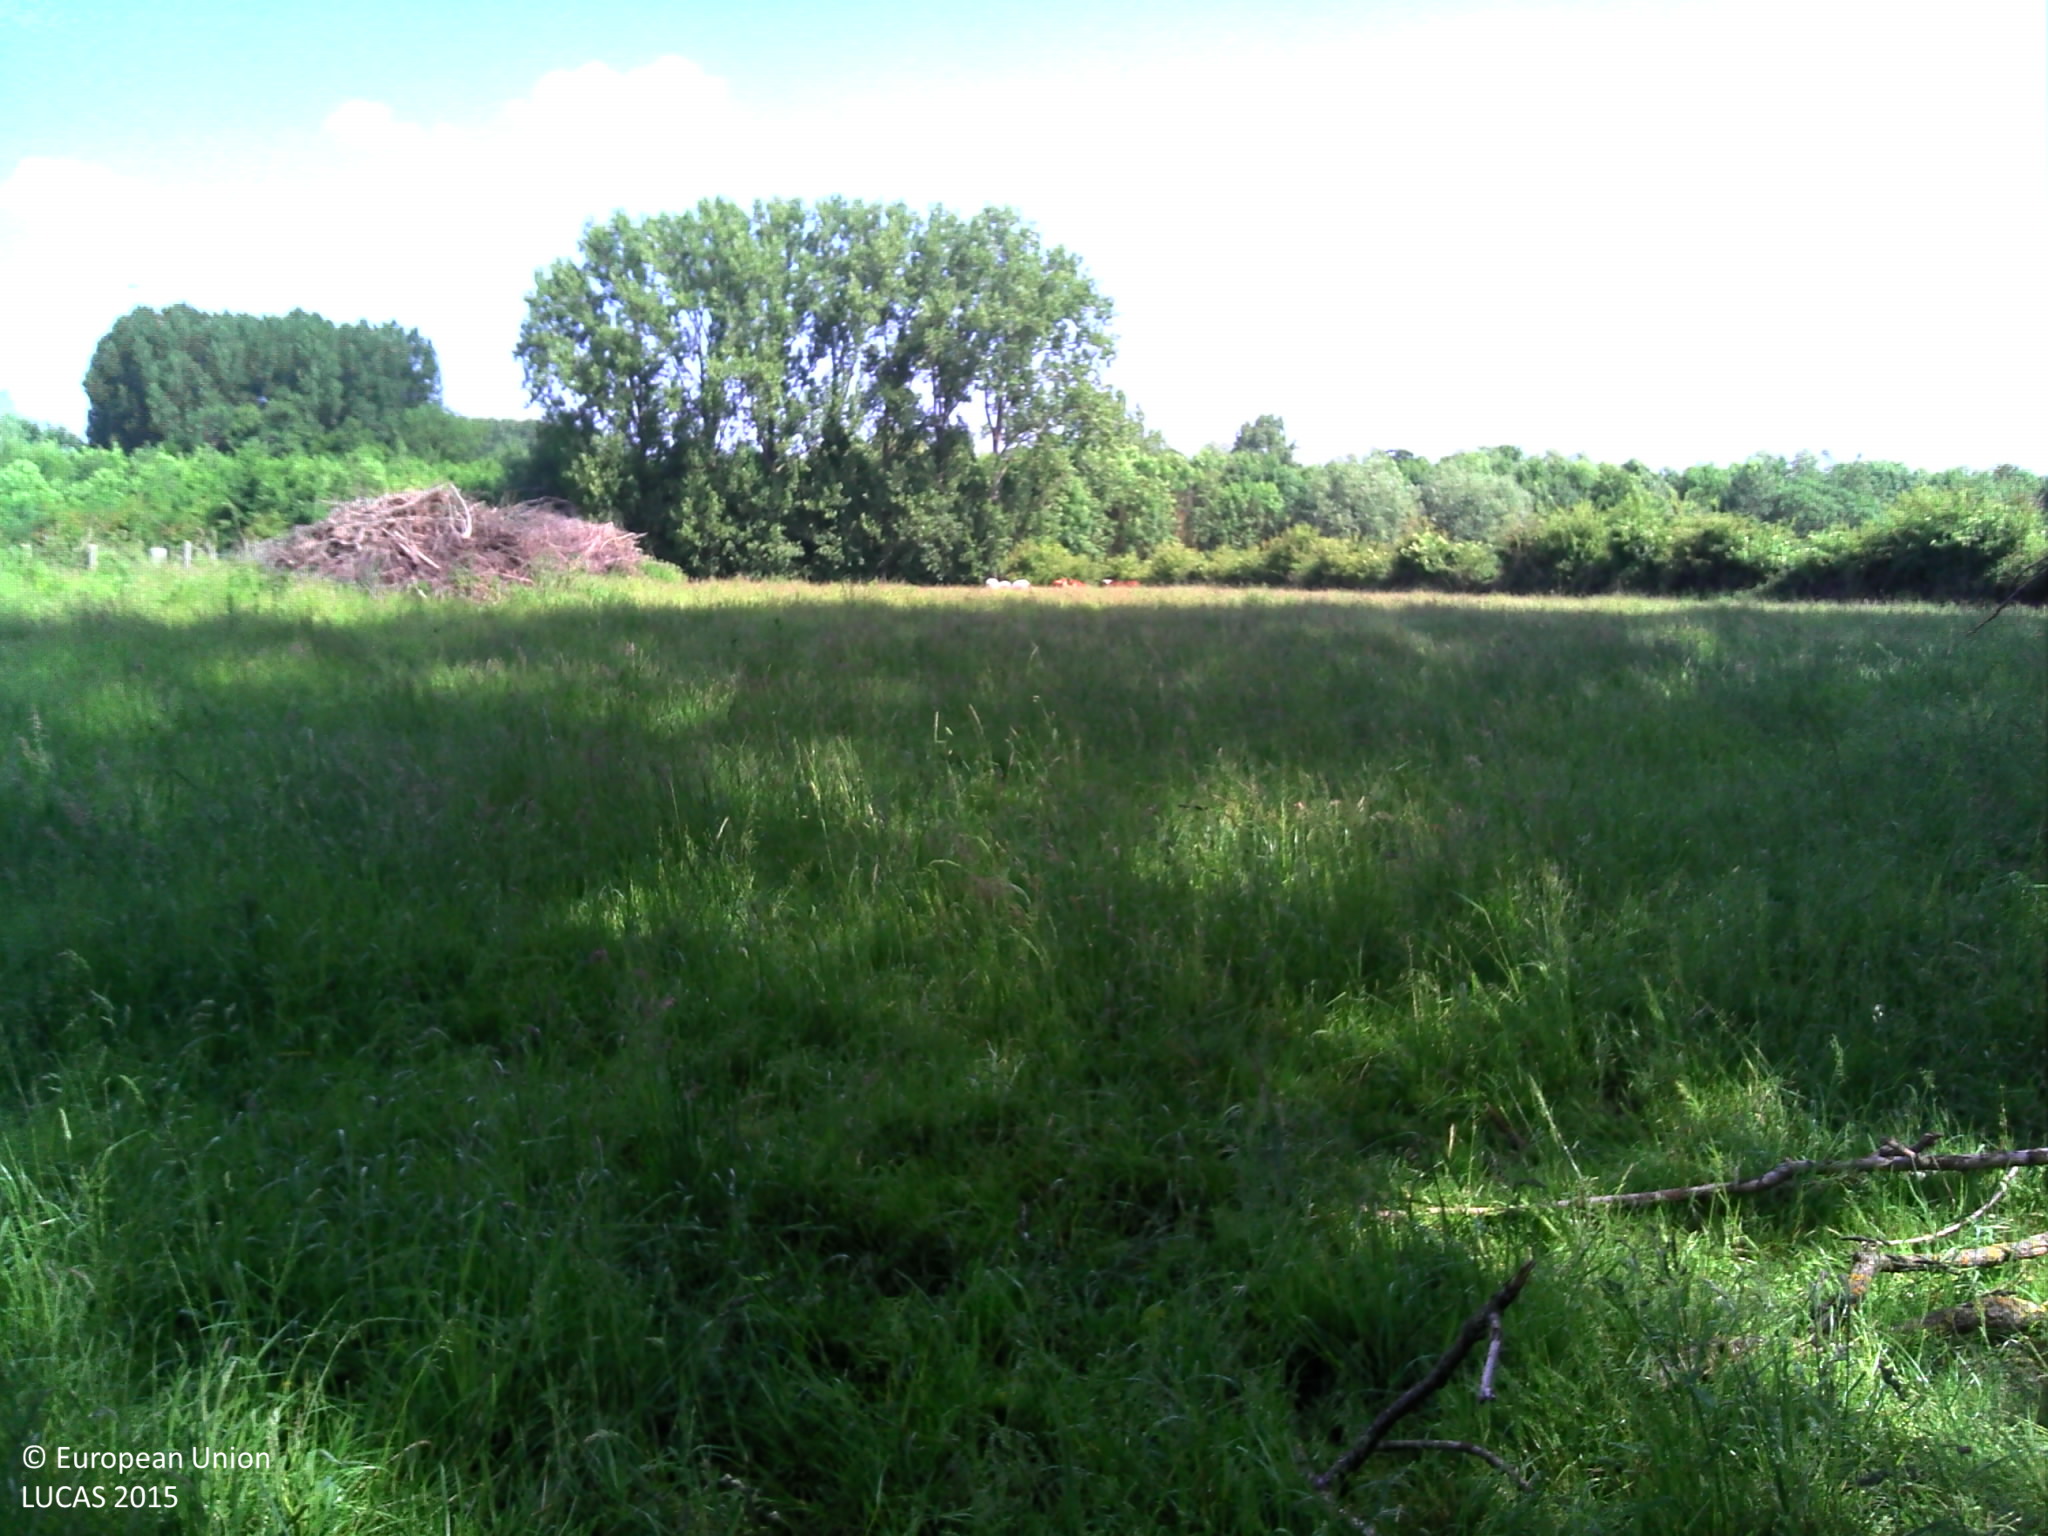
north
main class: Grassland
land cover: Grassland without tree/shrub cover
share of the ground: > 75 %
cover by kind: herbaceous plants 100 %
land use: Agriculture (excluding fallow land and kitchen gardens)
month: June
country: BE
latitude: 50.9236
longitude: 3.9192
